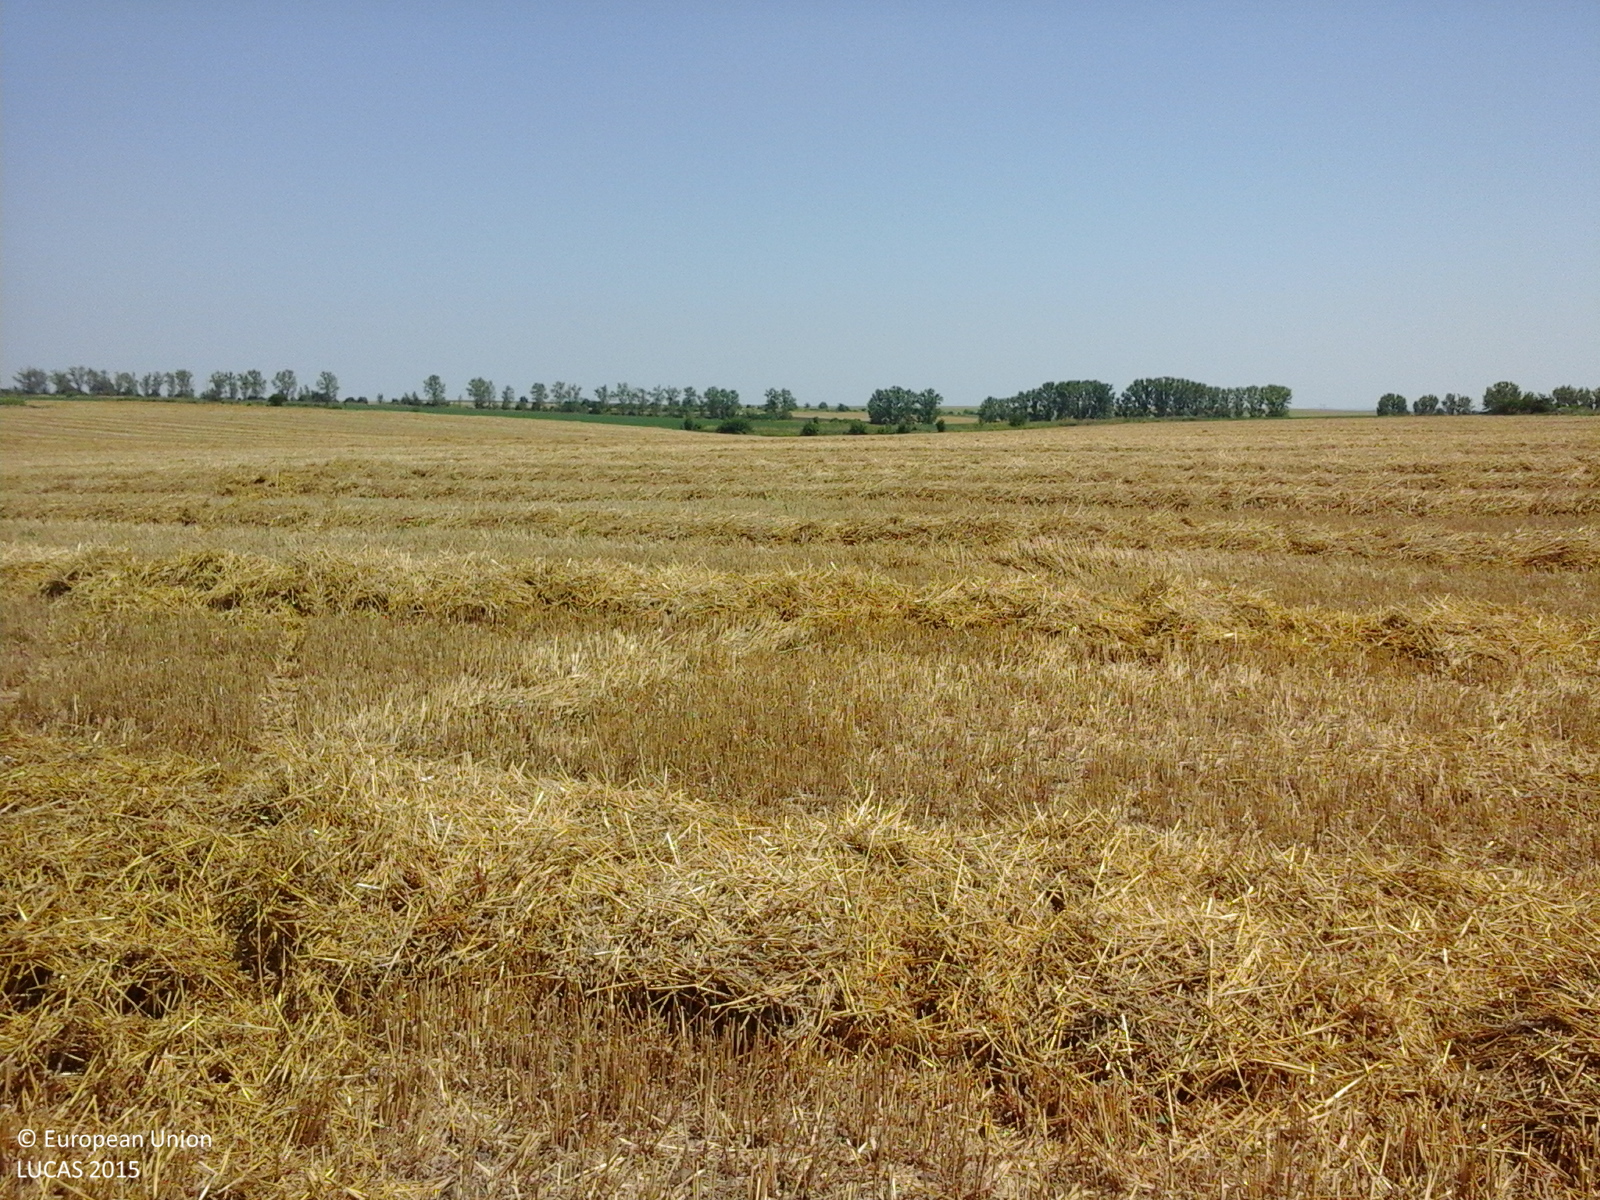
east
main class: Cropland
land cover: Common wheat
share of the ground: 50 - 75 %
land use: Agriculture (excluding fallow land and kitchen gardens)
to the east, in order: Common wheat
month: July
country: RO
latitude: 44.2294
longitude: 26.9632
